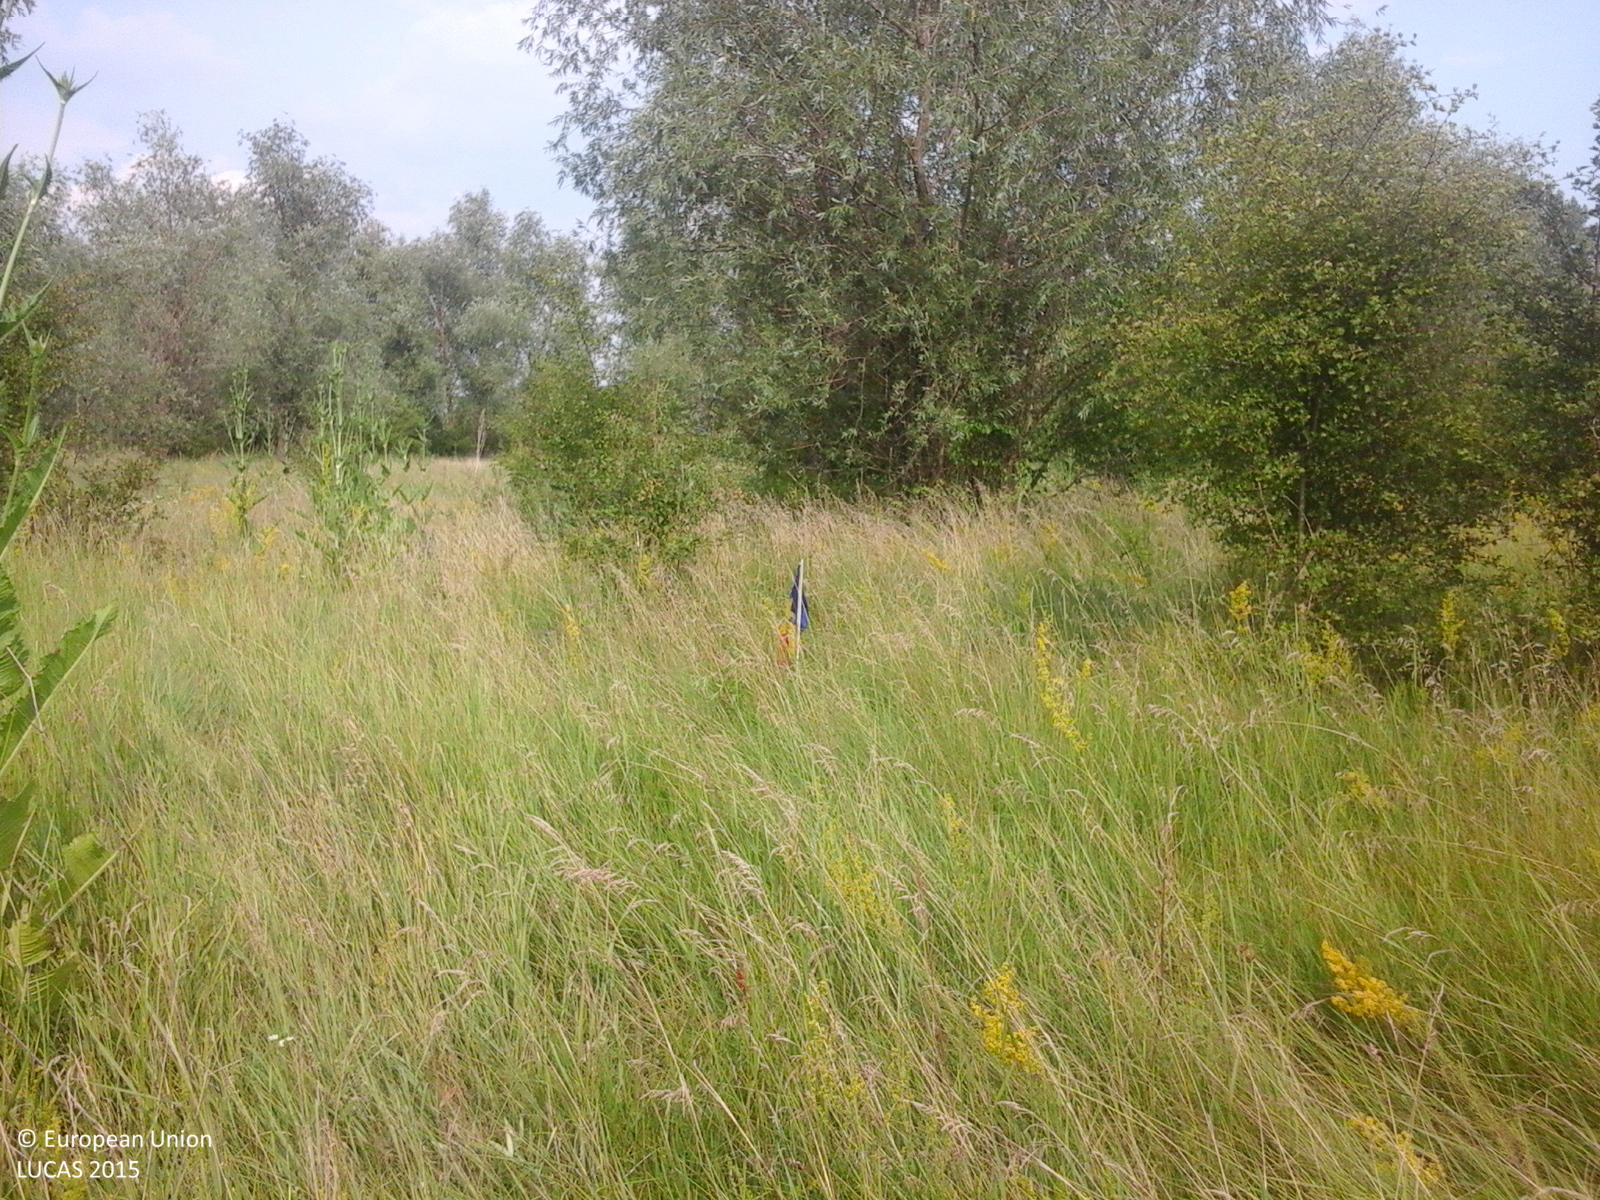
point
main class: Grassland
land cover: Grassland with sparse tree/shrub cover
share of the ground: > 75 %
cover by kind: herbaceous plants 85 %, shrubs 10 %, broadleaved forest trees 5 %
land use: Agriculture (excluding fallow land and kitchen gardens)
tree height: > 5 m
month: July
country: RO
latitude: 43.8237
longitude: 24.7290
